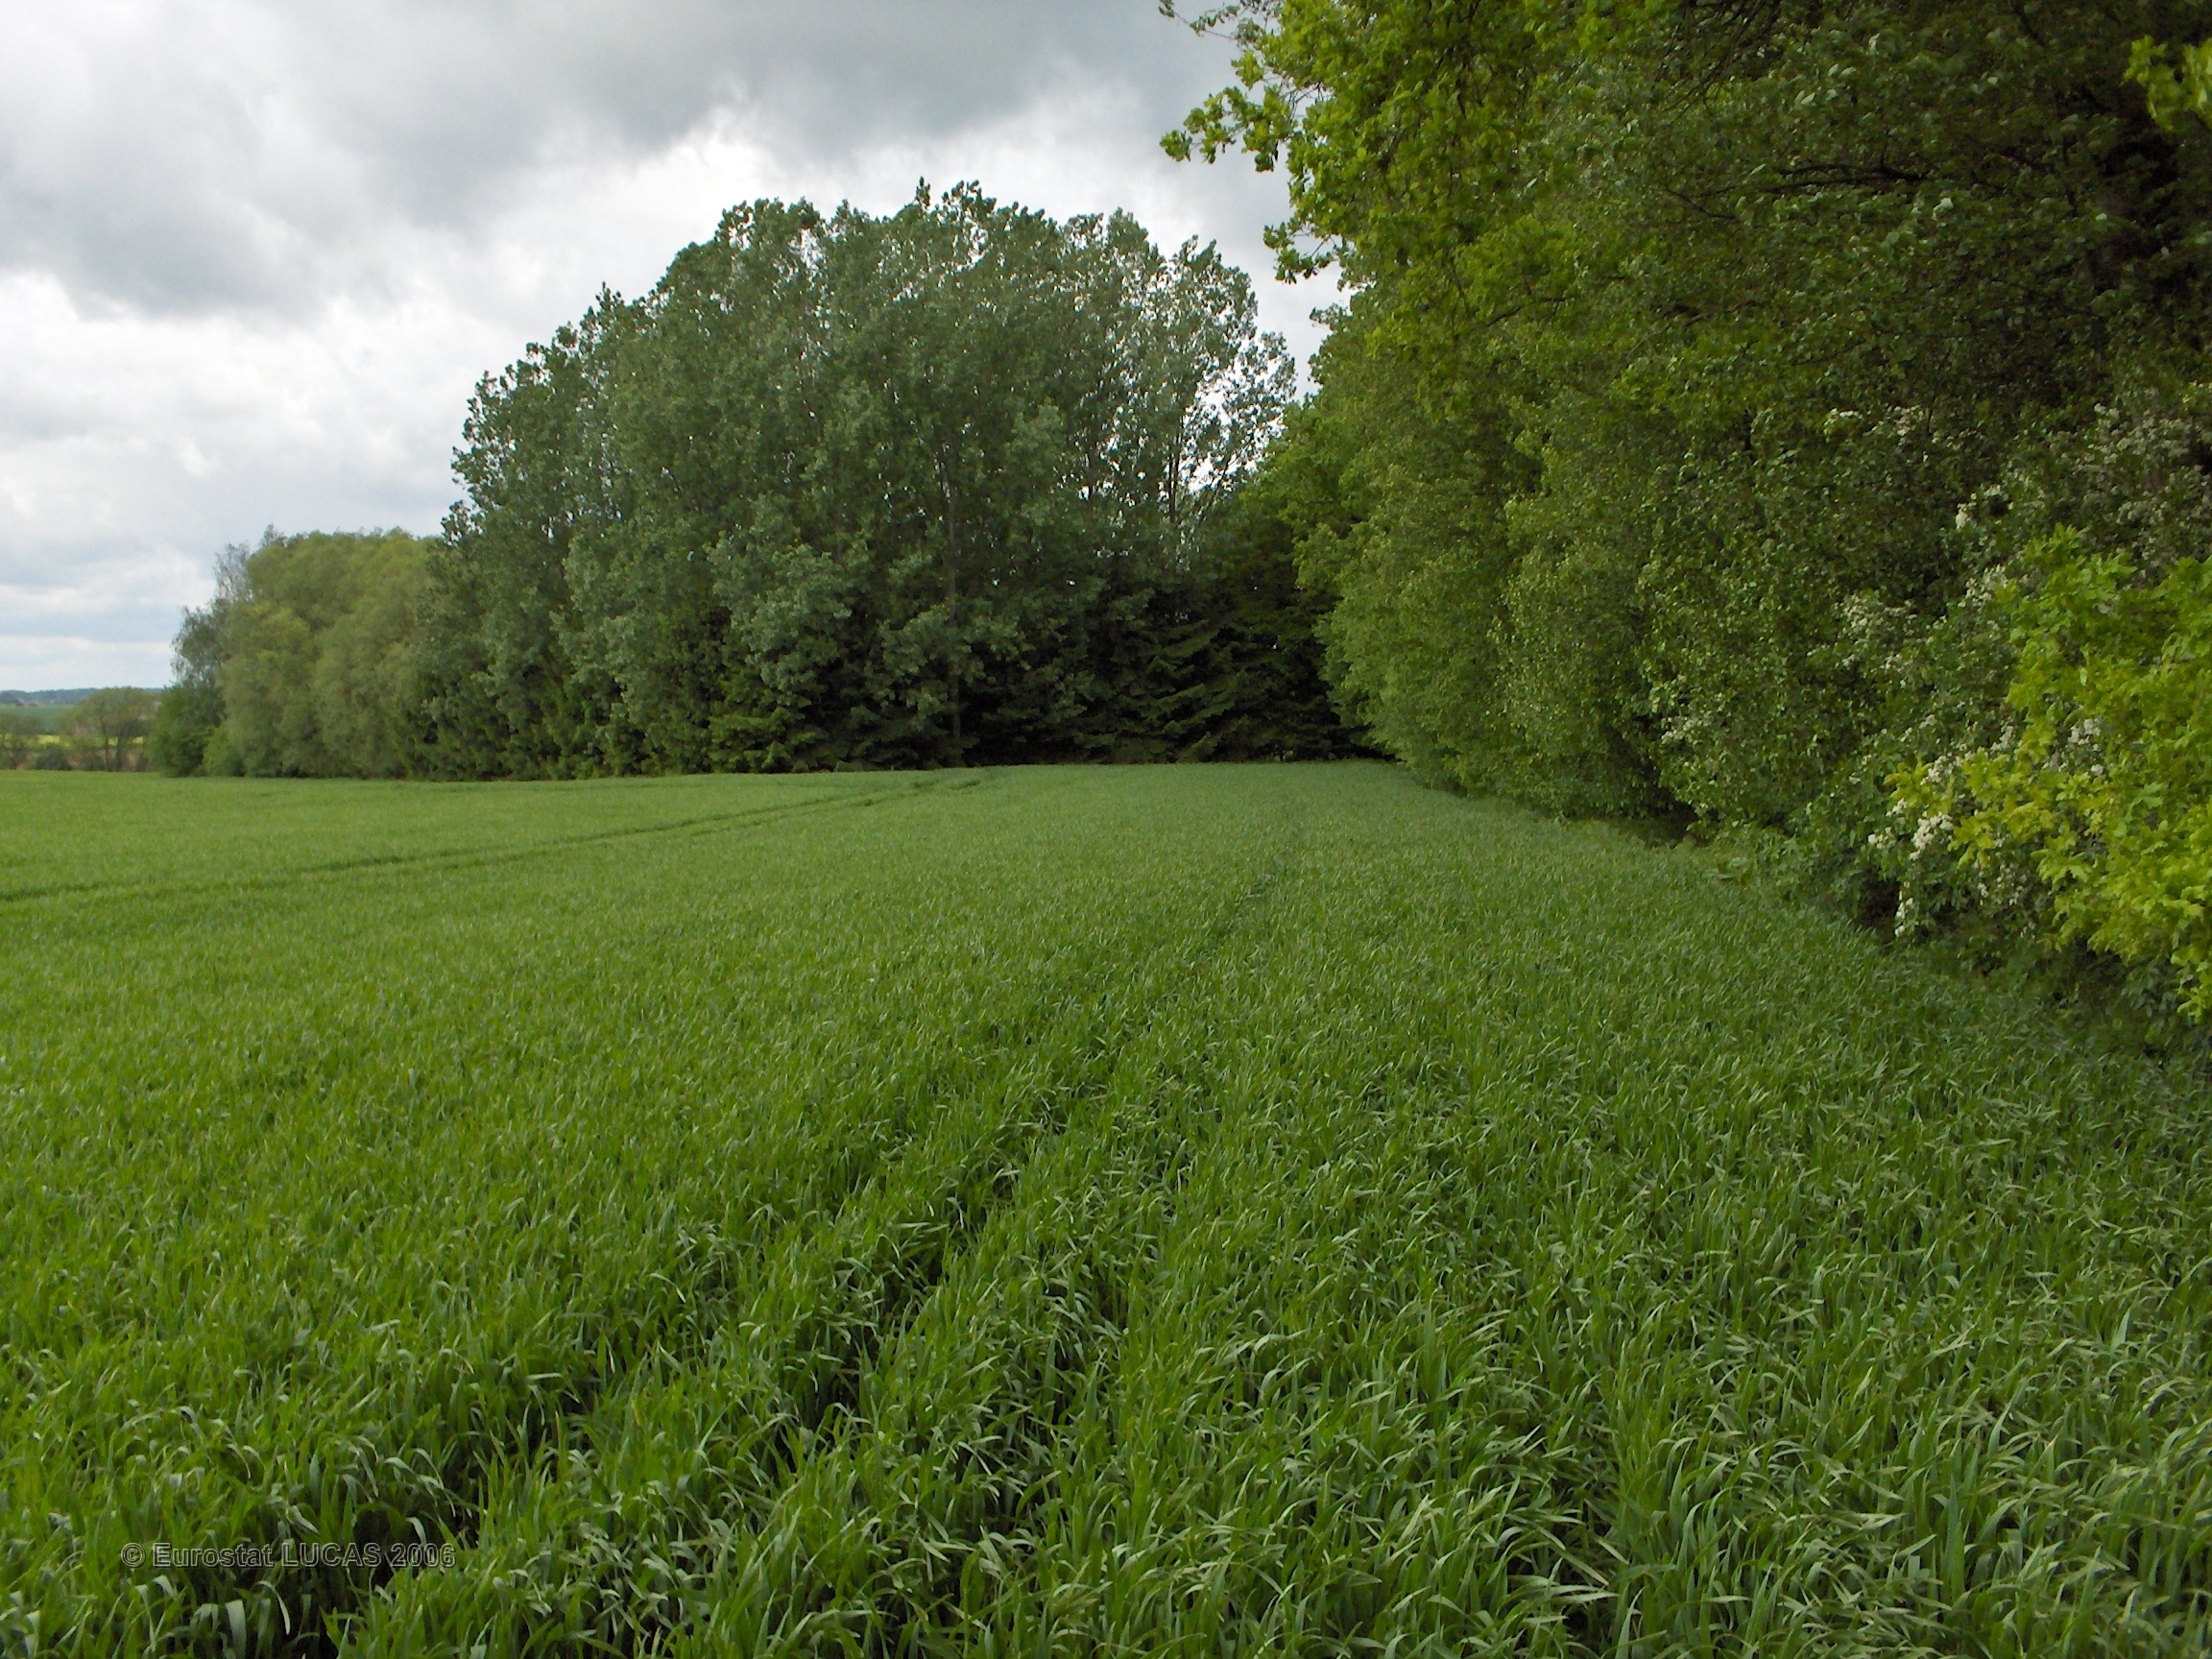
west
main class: Cropland
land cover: Common wheat
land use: Agriculture (excluding fallow land and kitchen gardens)
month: May
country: BE
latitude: 50.3248
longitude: 4.5602
